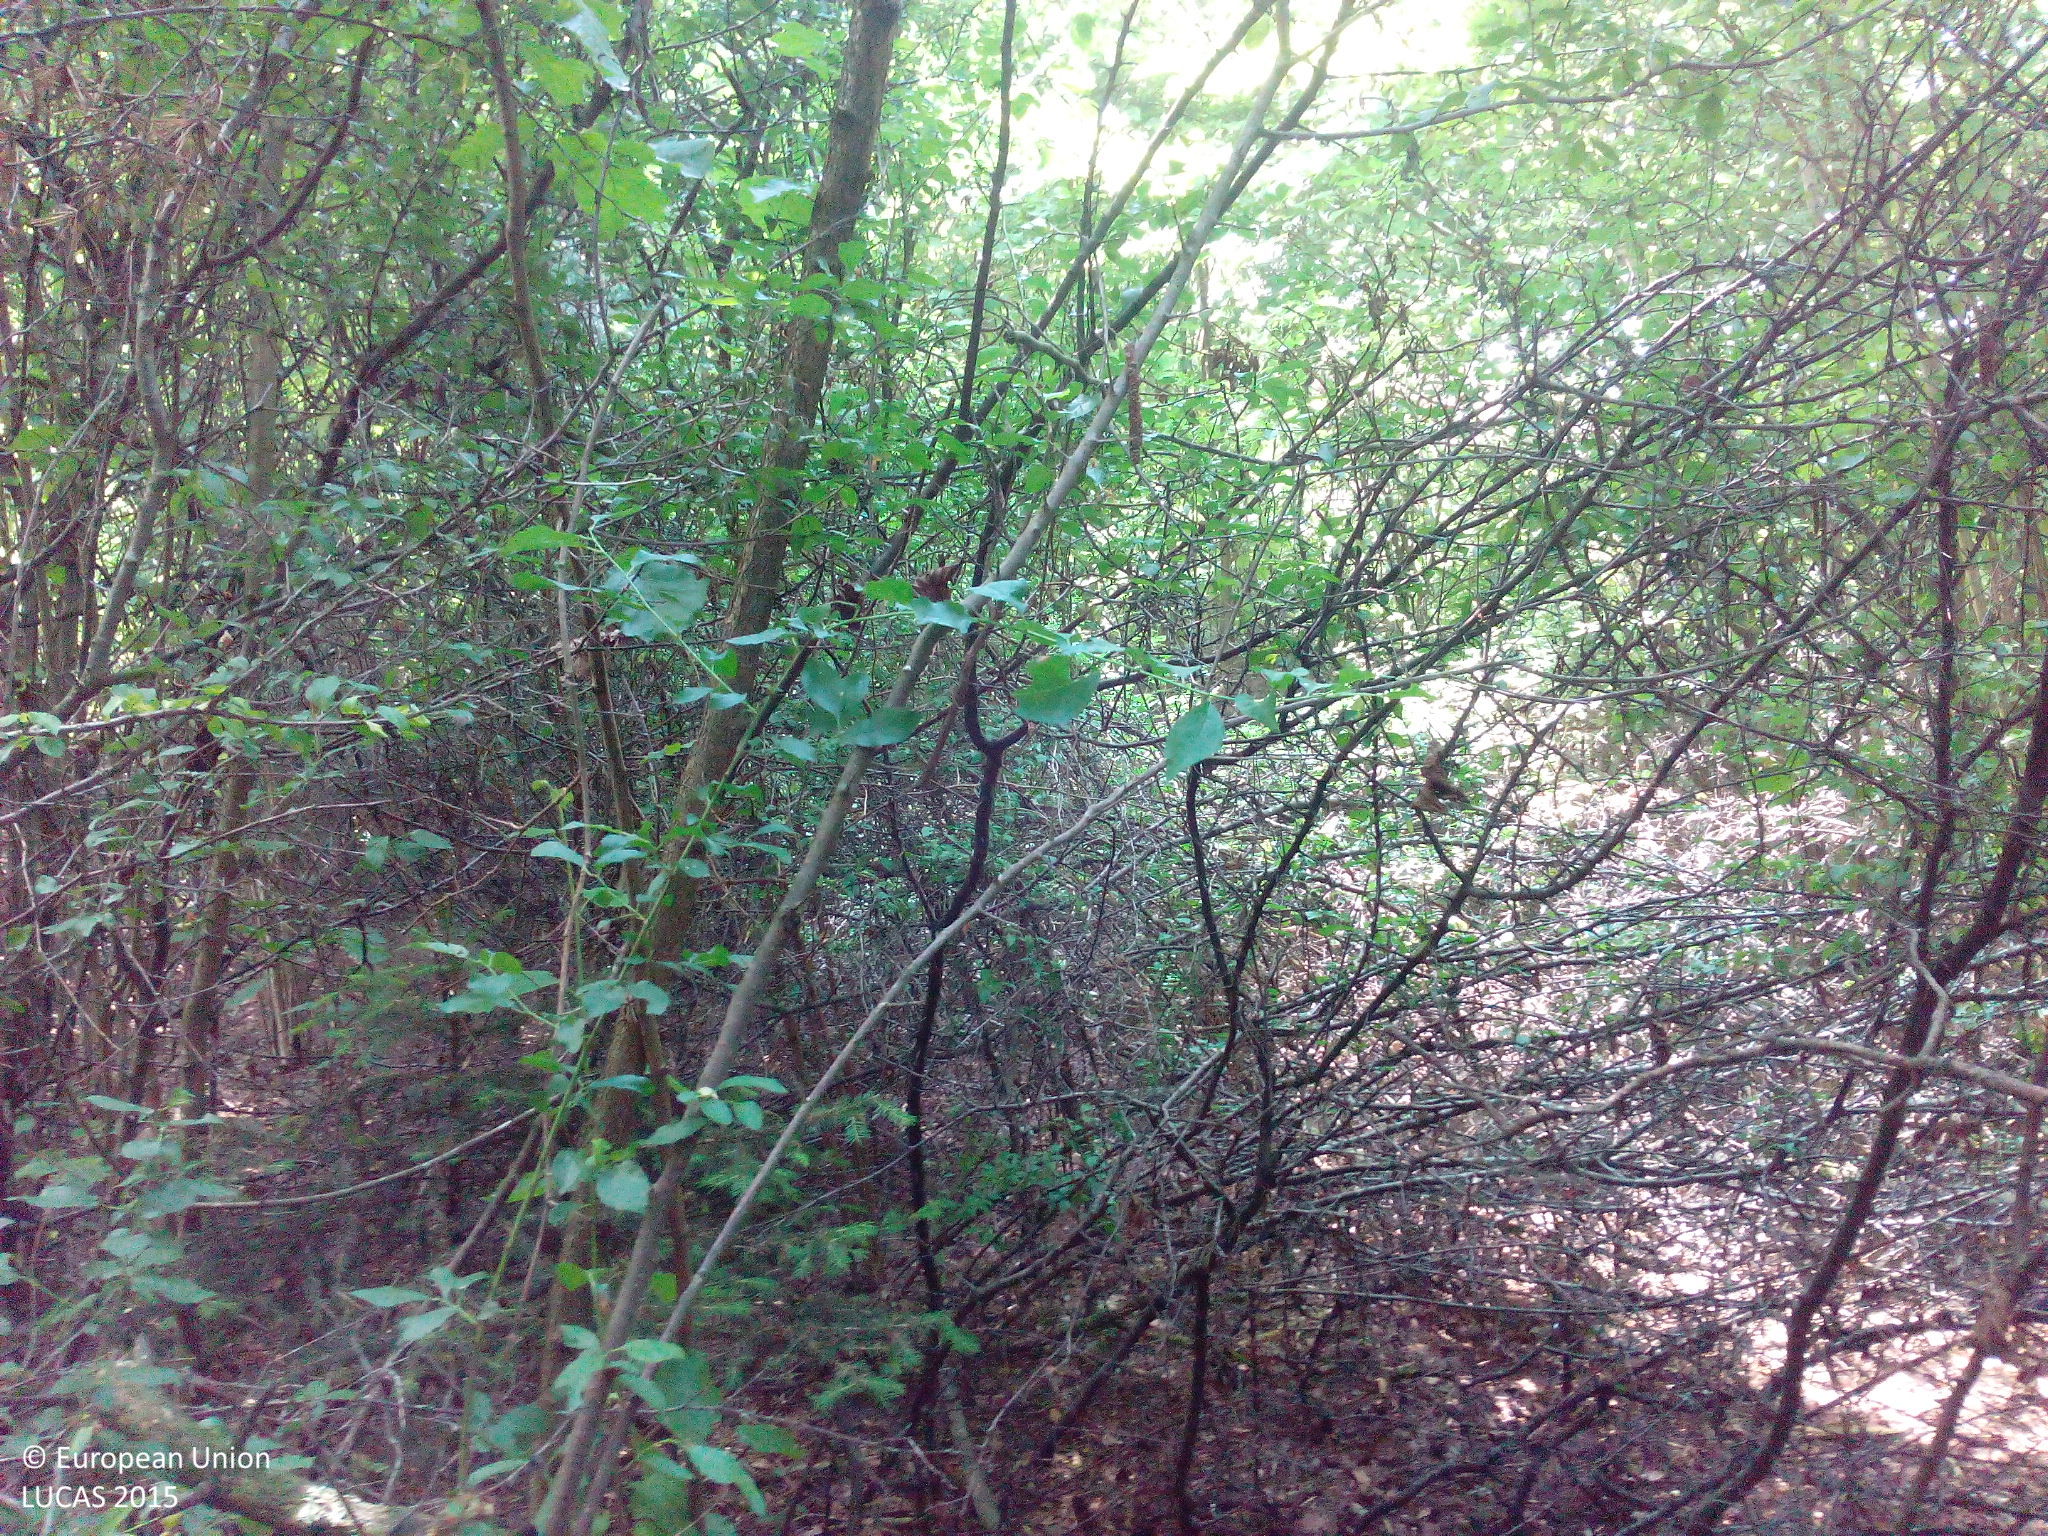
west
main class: Woodland
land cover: Spruce dominated mixed woodland
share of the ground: > 75 %
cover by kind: broadleaved forest trees 55 %, coniferous forest trees 35 %, shrubs 10 %
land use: Semi-natural and natural areas not in use
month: July
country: DE
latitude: 48.4030
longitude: 9.6895
